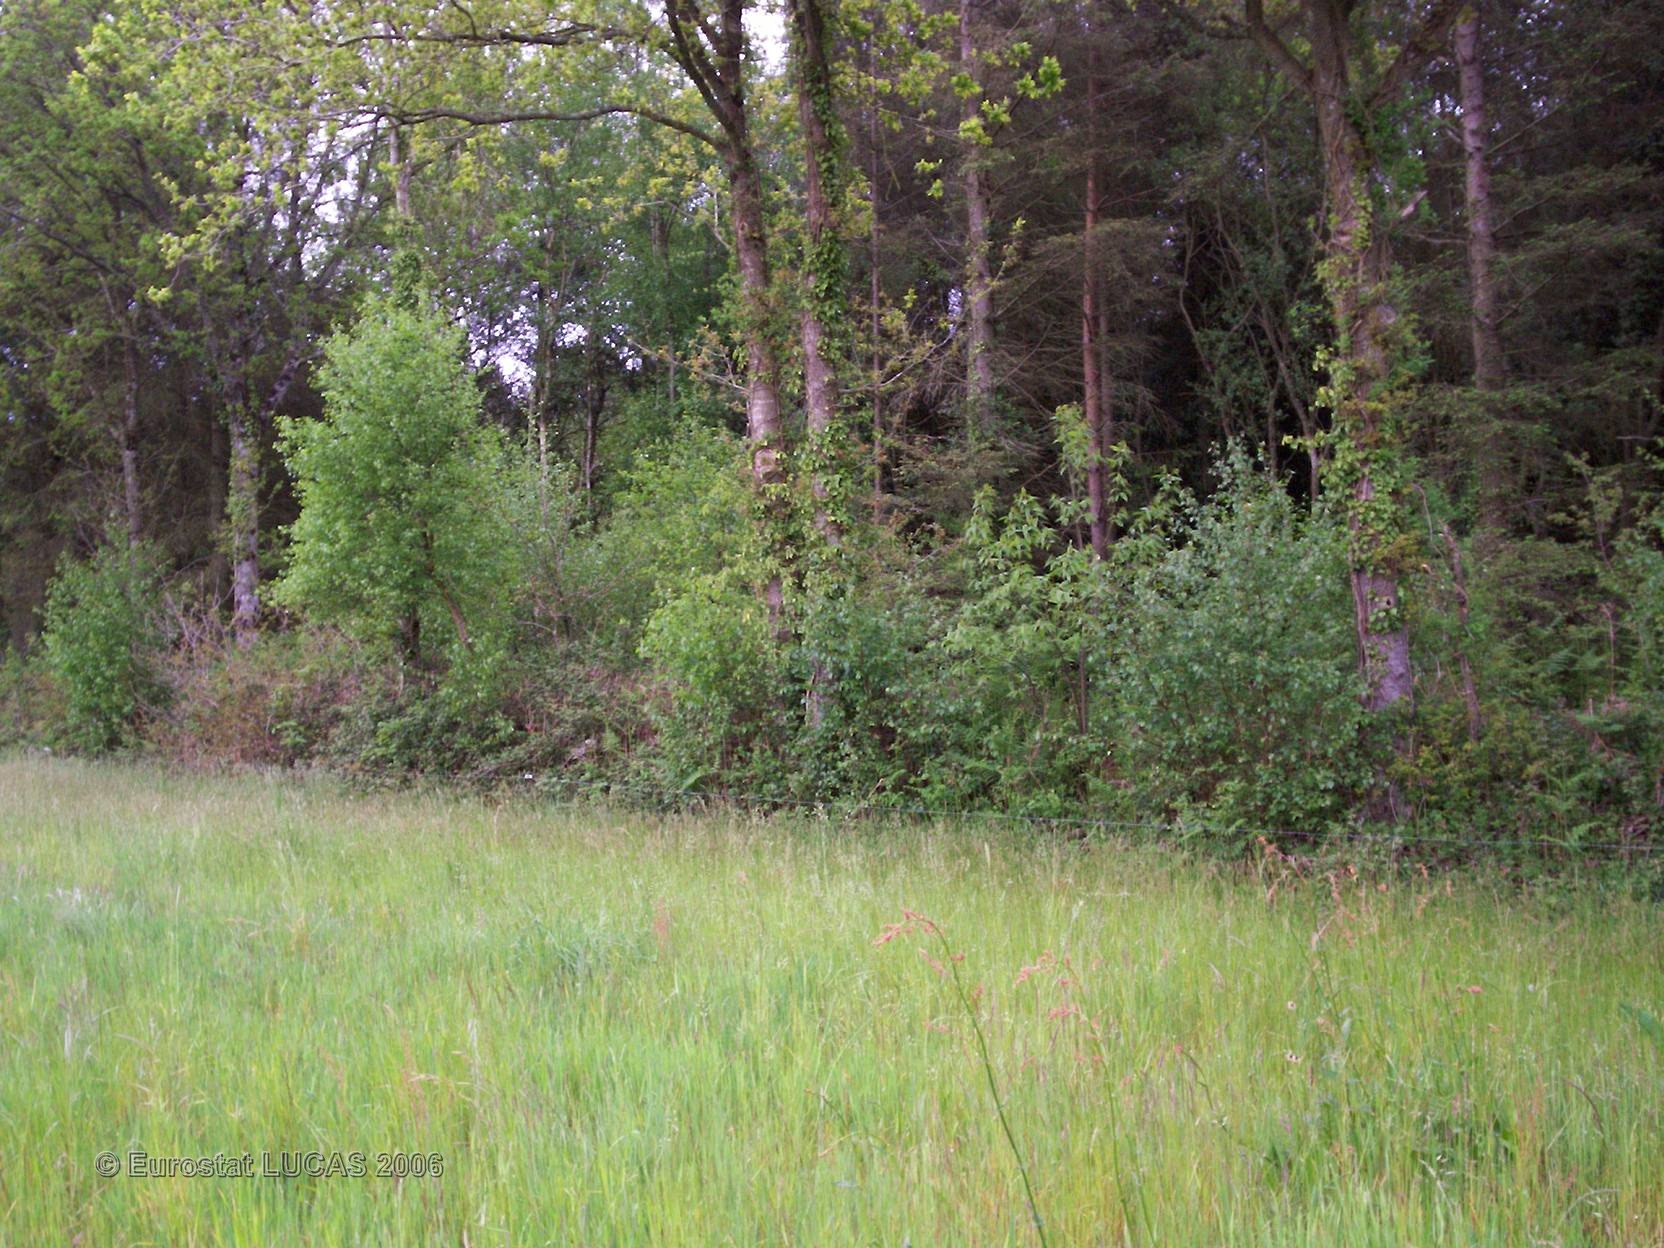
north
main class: Grassland
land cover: Grassland without tree/shrub cover
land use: Agriculture (excluding fallow land and kitchen gardens)
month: May
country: FR
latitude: 48.6630
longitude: -3.8123
